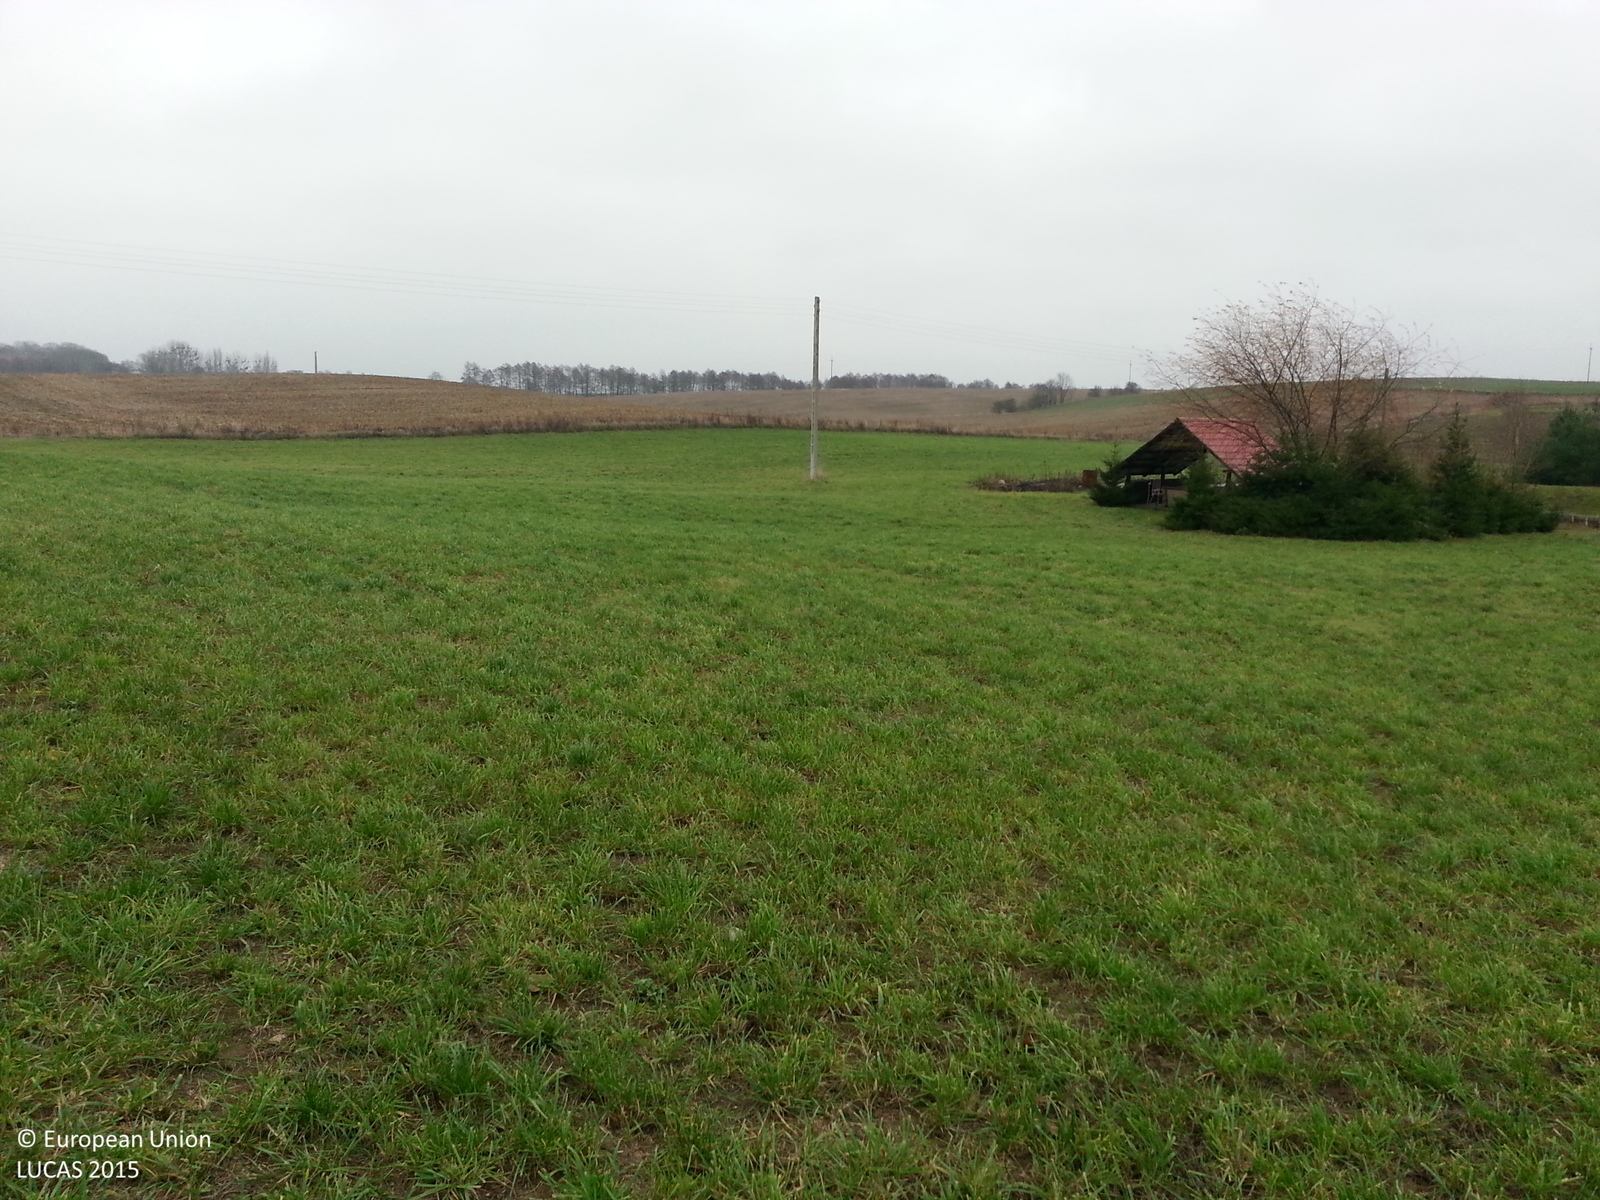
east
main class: Grassland
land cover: Grassland without tree/shrub cover
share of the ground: > 75 %
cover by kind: herbaceous plants 85 %, unconsolidated bare surface 15 %
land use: Residential
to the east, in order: Grassland without tree/shrub cover; Electric lines; Grassland without tree/shrub cover; Maize
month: October
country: PL
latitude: 53.3406
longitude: 19.2008
